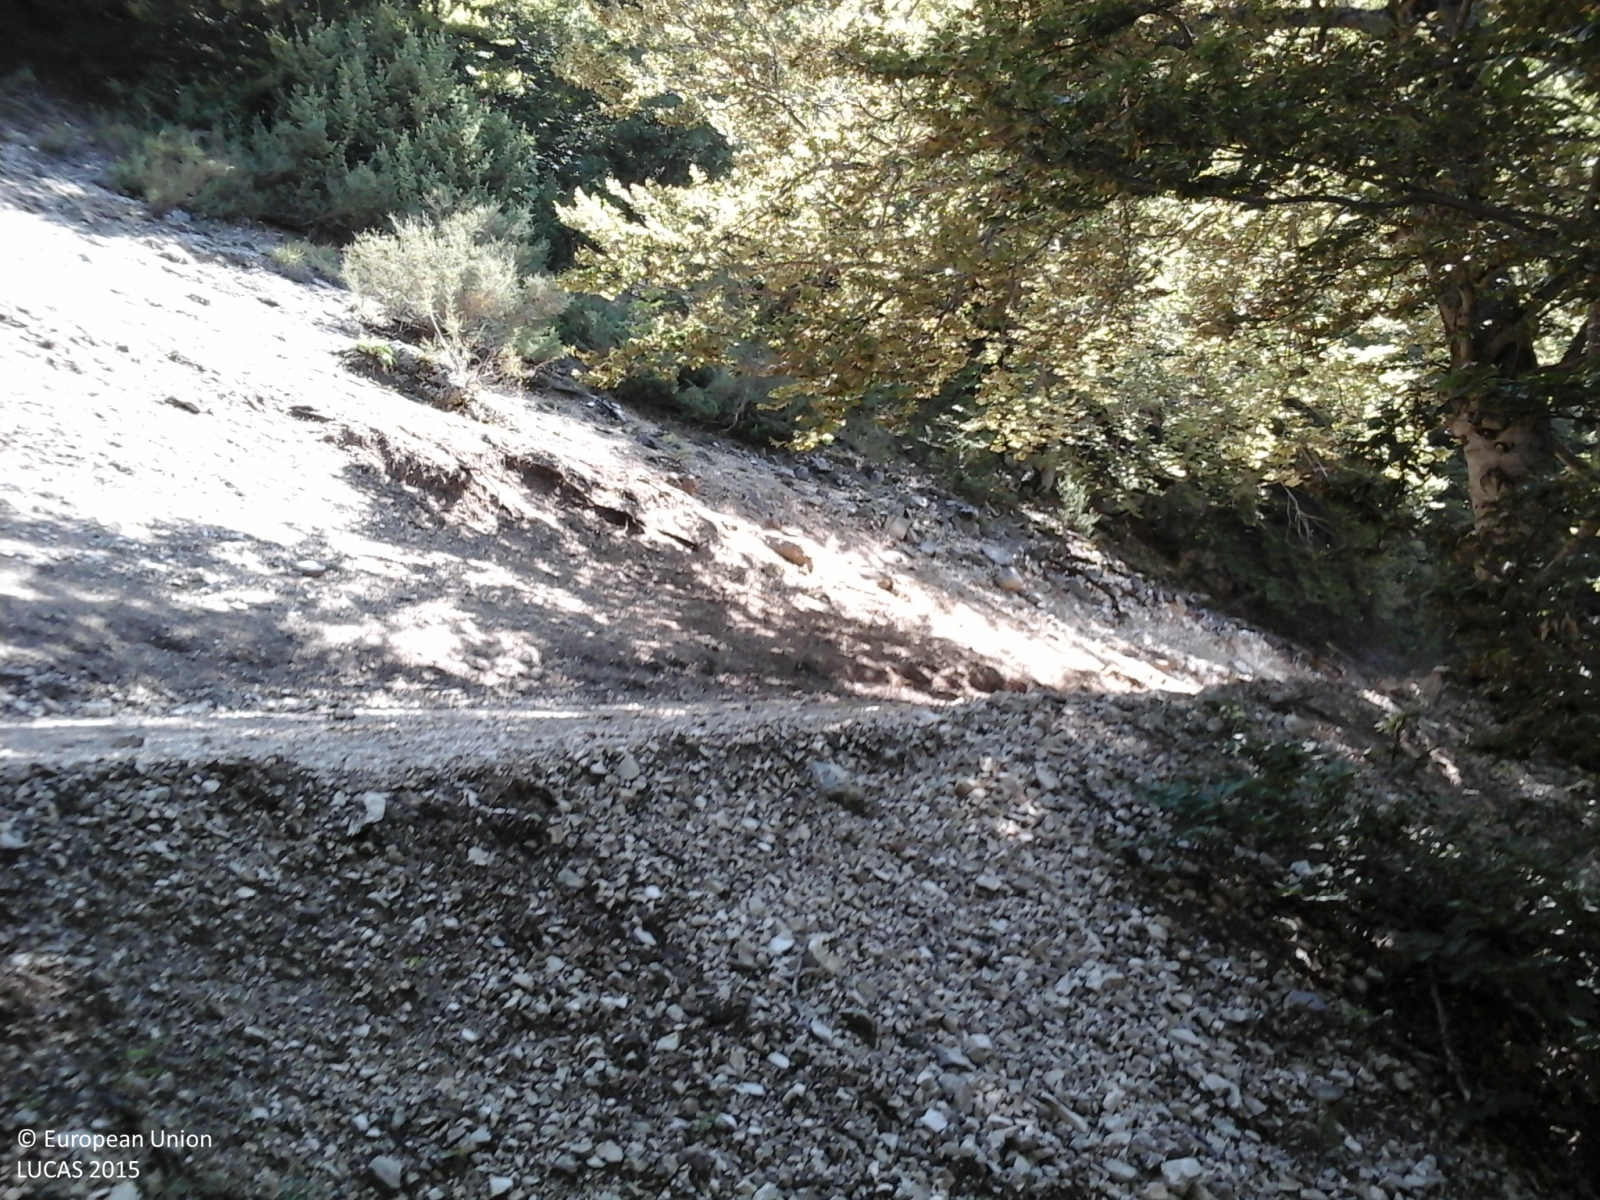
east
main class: Woodland
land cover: Broadleaved woodland
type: mountainous beech forest
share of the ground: > 75 %
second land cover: Grassland without tree/shrub cover
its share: < 10 %
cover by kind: broadleaved forest trees 90 %, herbaceous plants 10 %
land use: Forestry
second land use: Agriculture (excluding fallow land and kitchen gardens)
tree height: > 5 m
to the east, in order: Broadleaved woodland; Grassland without tree/shrub cover; Fences; Tracks; Broadleaved woodland; Grassland without tree/shrub cover
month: August
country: IT
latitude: 42.8577
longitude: 13.1605
